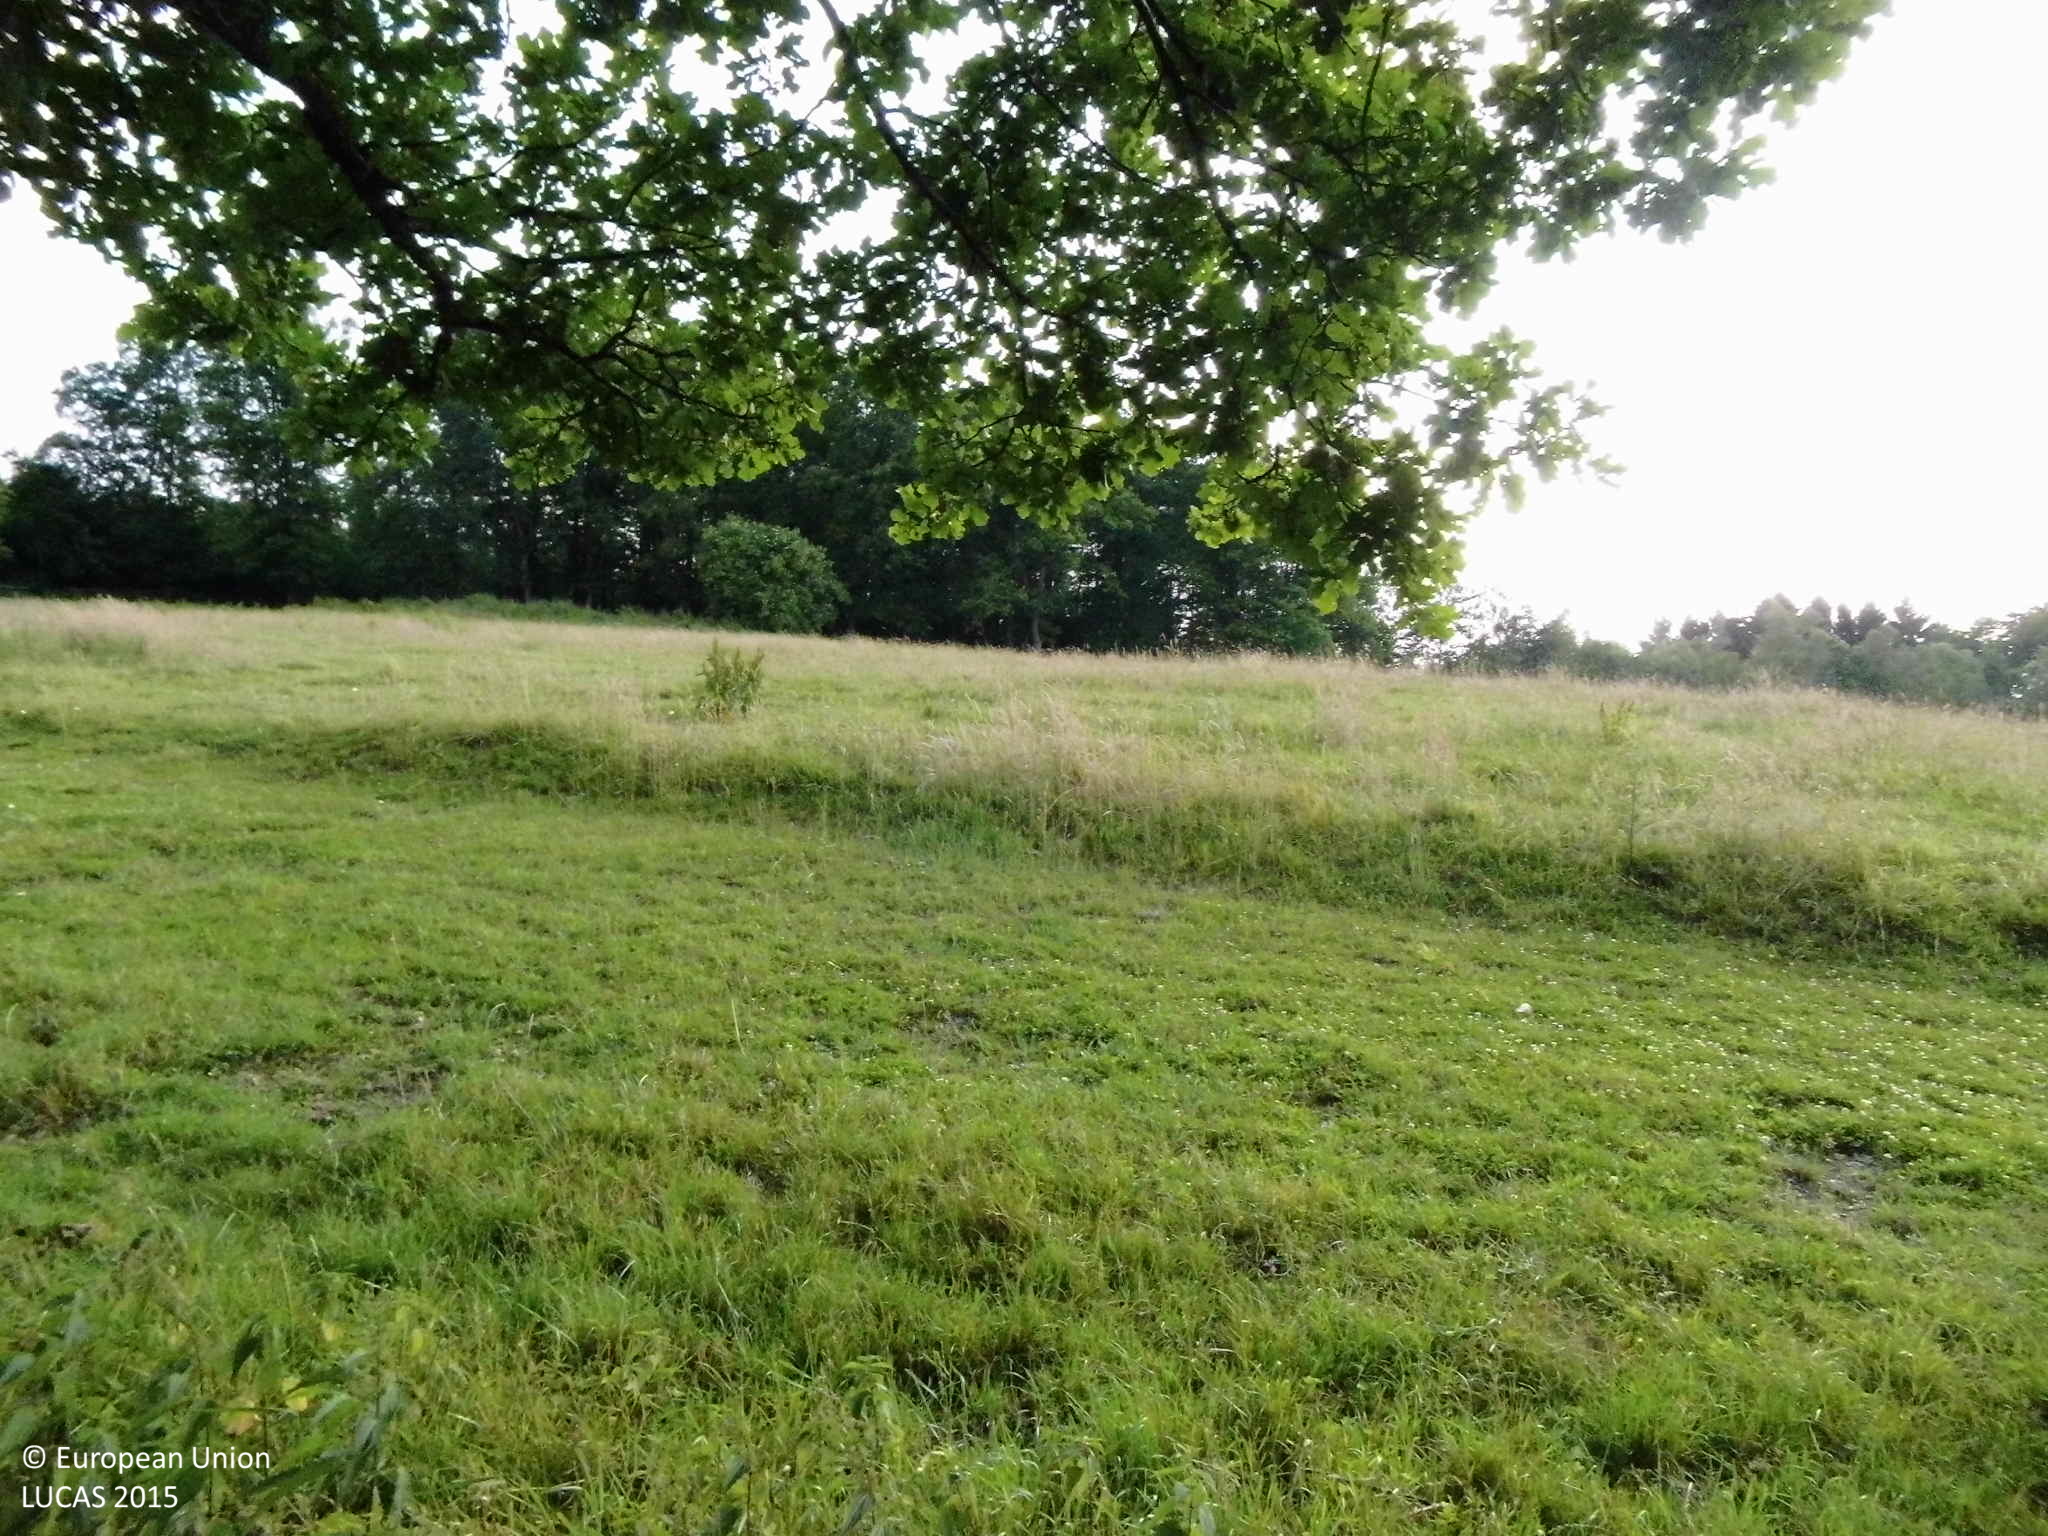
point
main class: Grassland
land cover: Grassland without tree/shrub cover
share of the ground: > 75 %
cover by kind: herbaceous plants 100 %
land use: Agriculture (excluding fallow land and kitchen gardens)
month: June
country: DE
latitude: 50.8773
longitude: 7.5415
